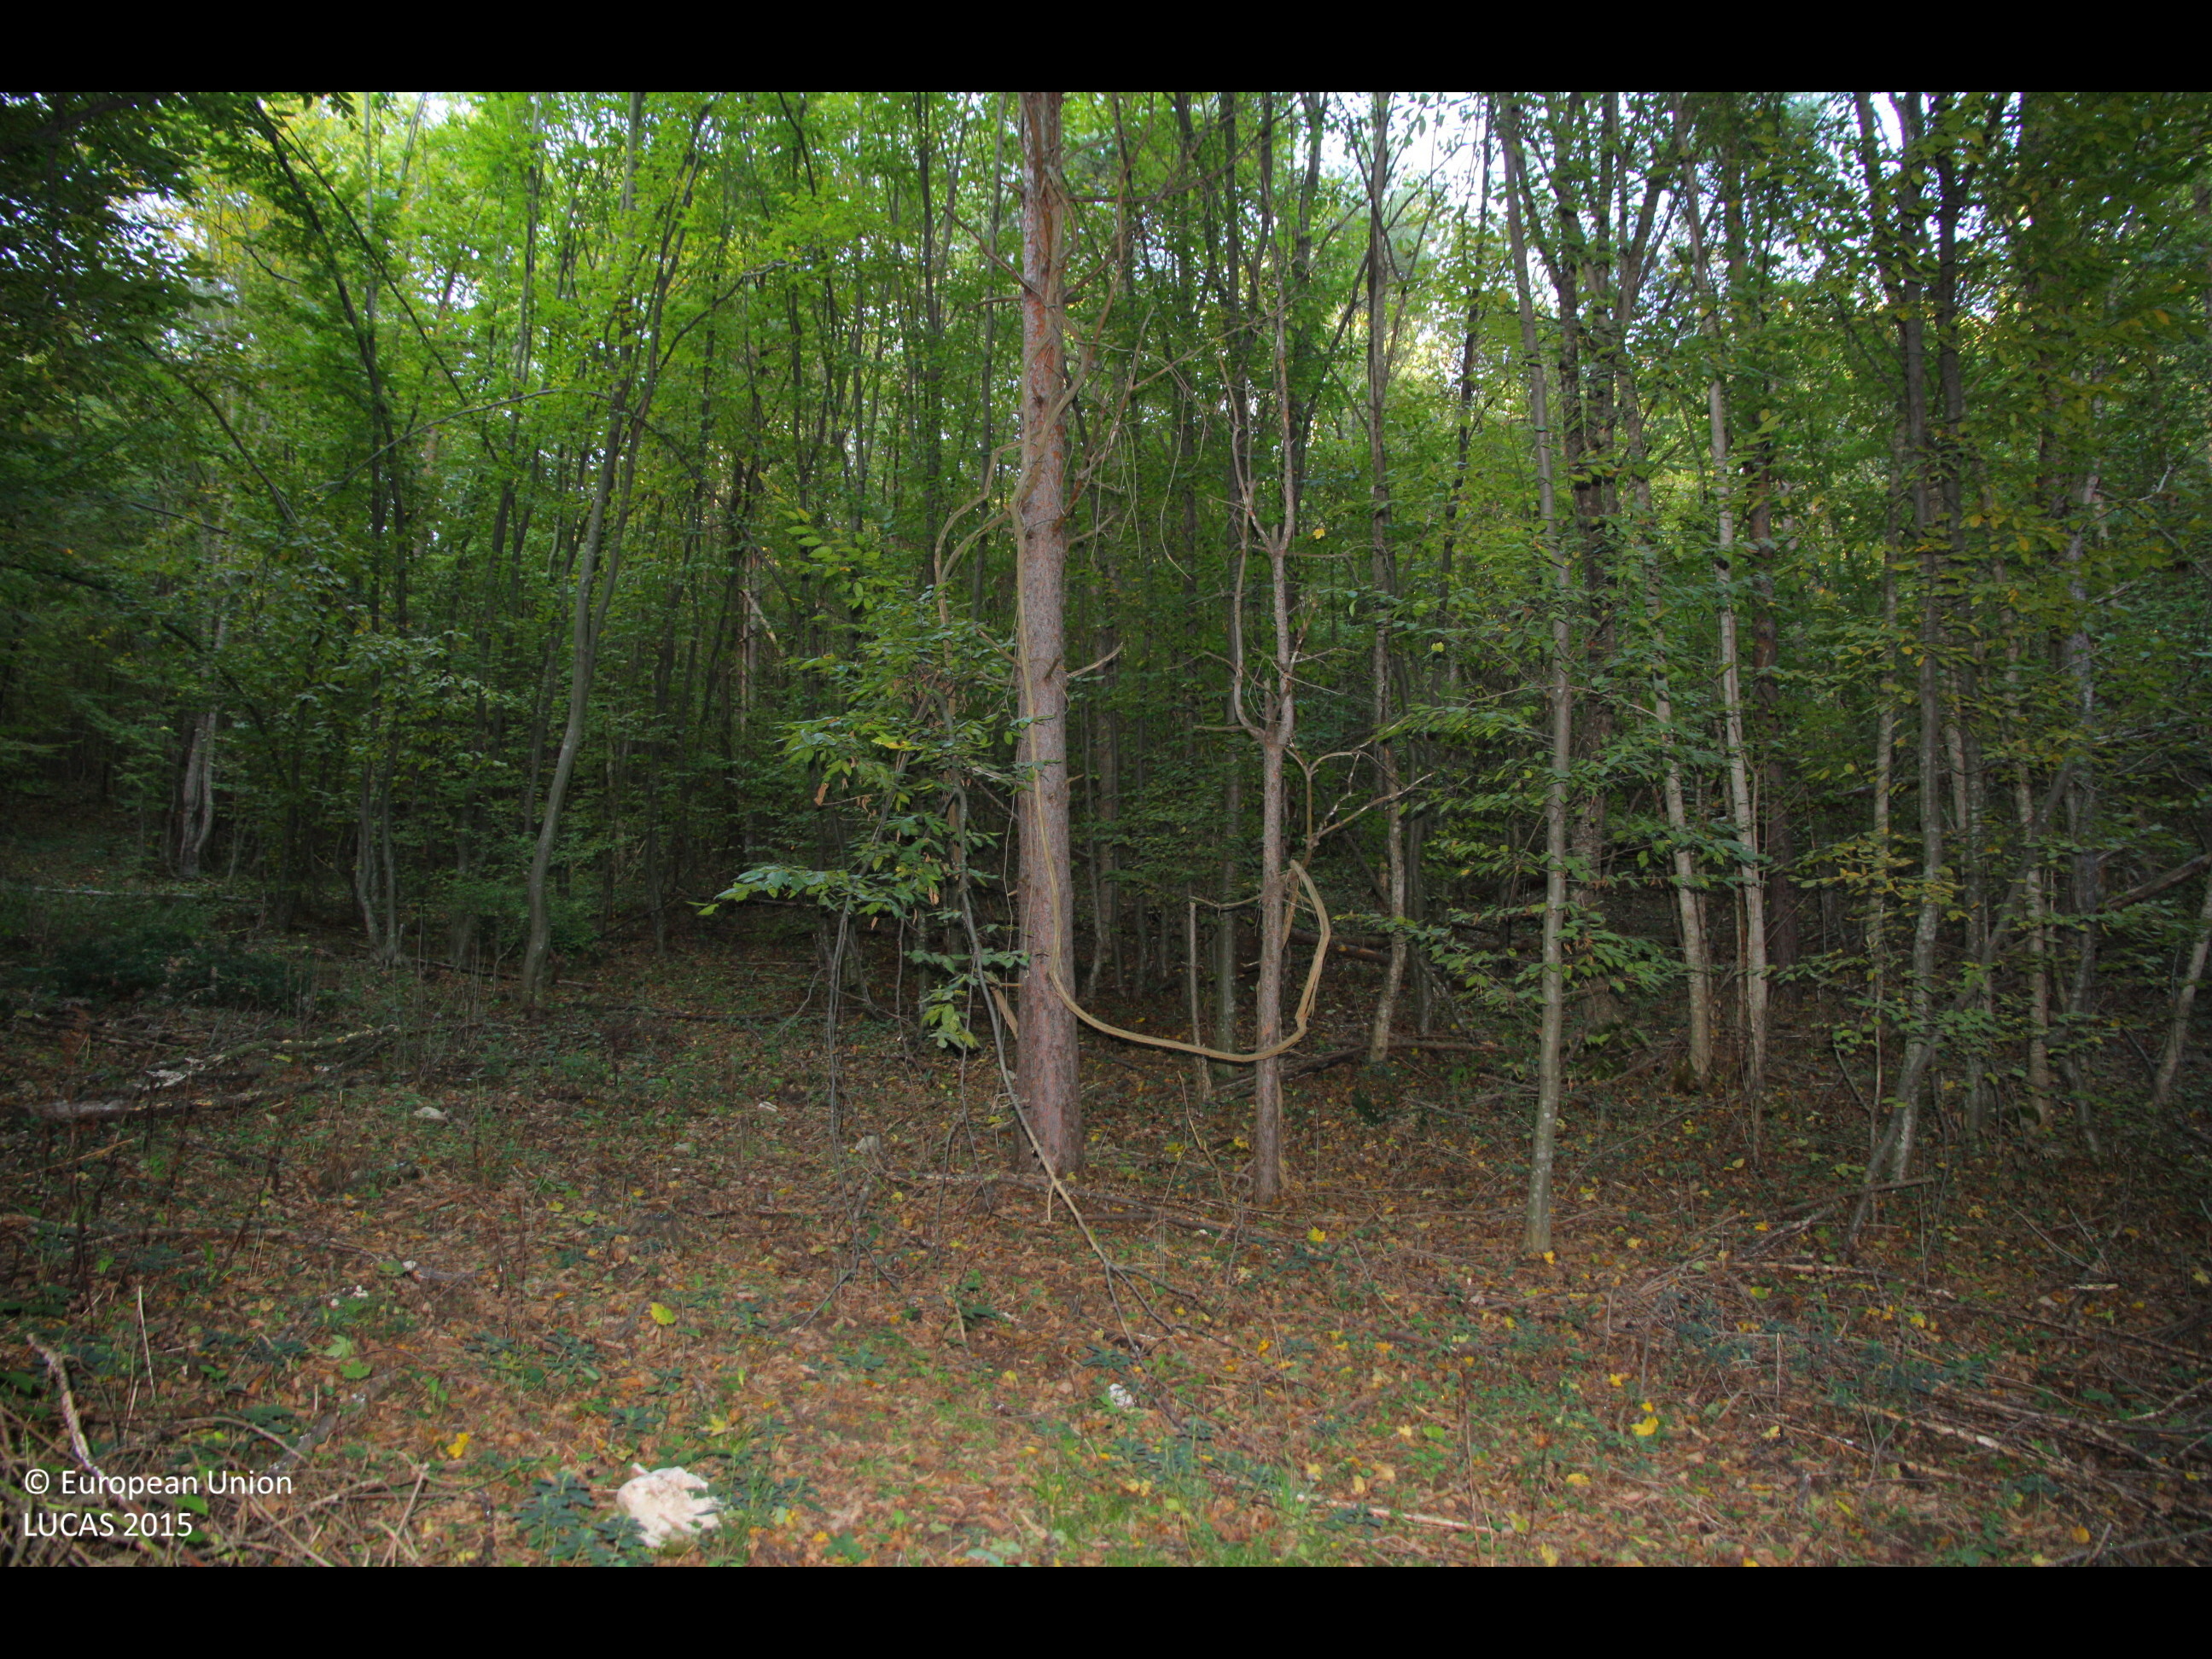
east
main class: Woodland
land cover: Other mixed woodland
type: acidophilous oak and oak-birch forest
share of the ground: > 75 %
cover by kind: broadleaved forest trees 75 %, coniferous forest trees 25 %
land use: Forestry
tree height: > 5 m
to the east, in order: Other mixed woodland
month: October
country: BG
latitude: 42.9513
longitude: 27.0134
